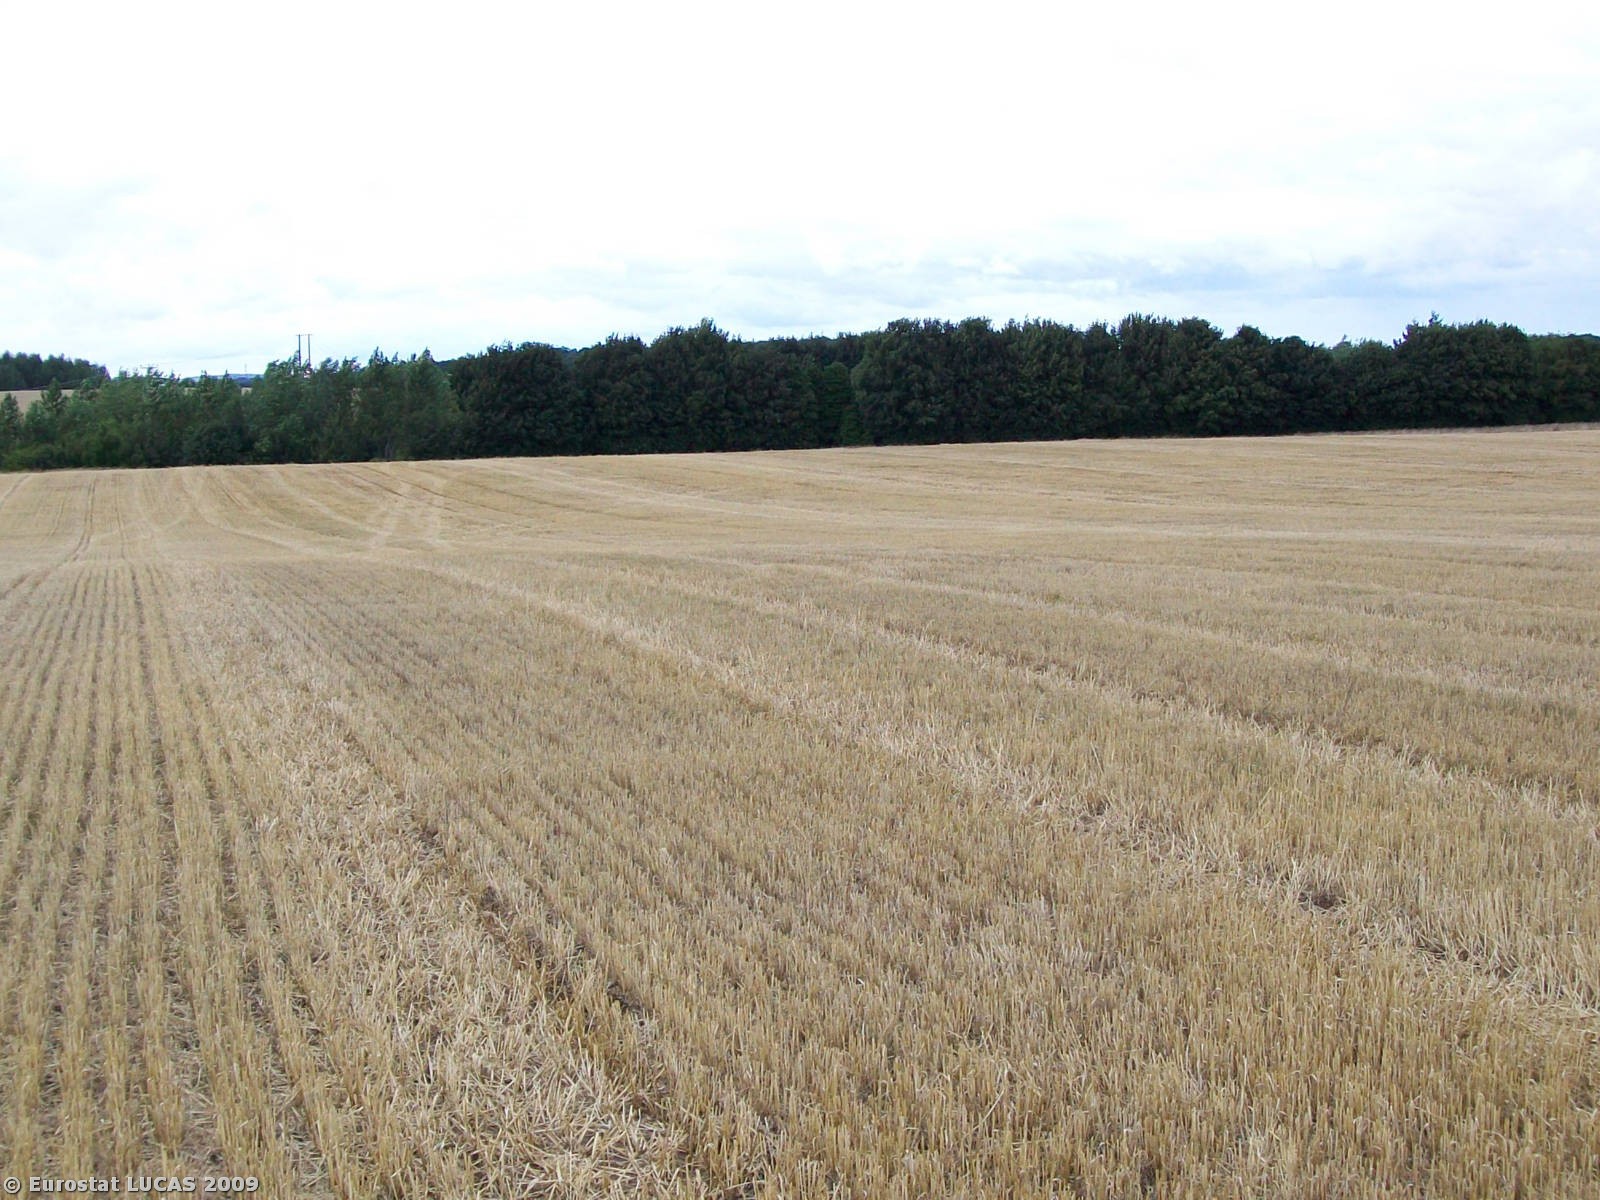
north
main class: Cropland
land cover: Barley
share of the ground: > 75 %
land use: Agriculture (excluding fallow land and kitchen gardens)
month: August
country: GB
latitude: 55.6324
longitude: -2.2717
